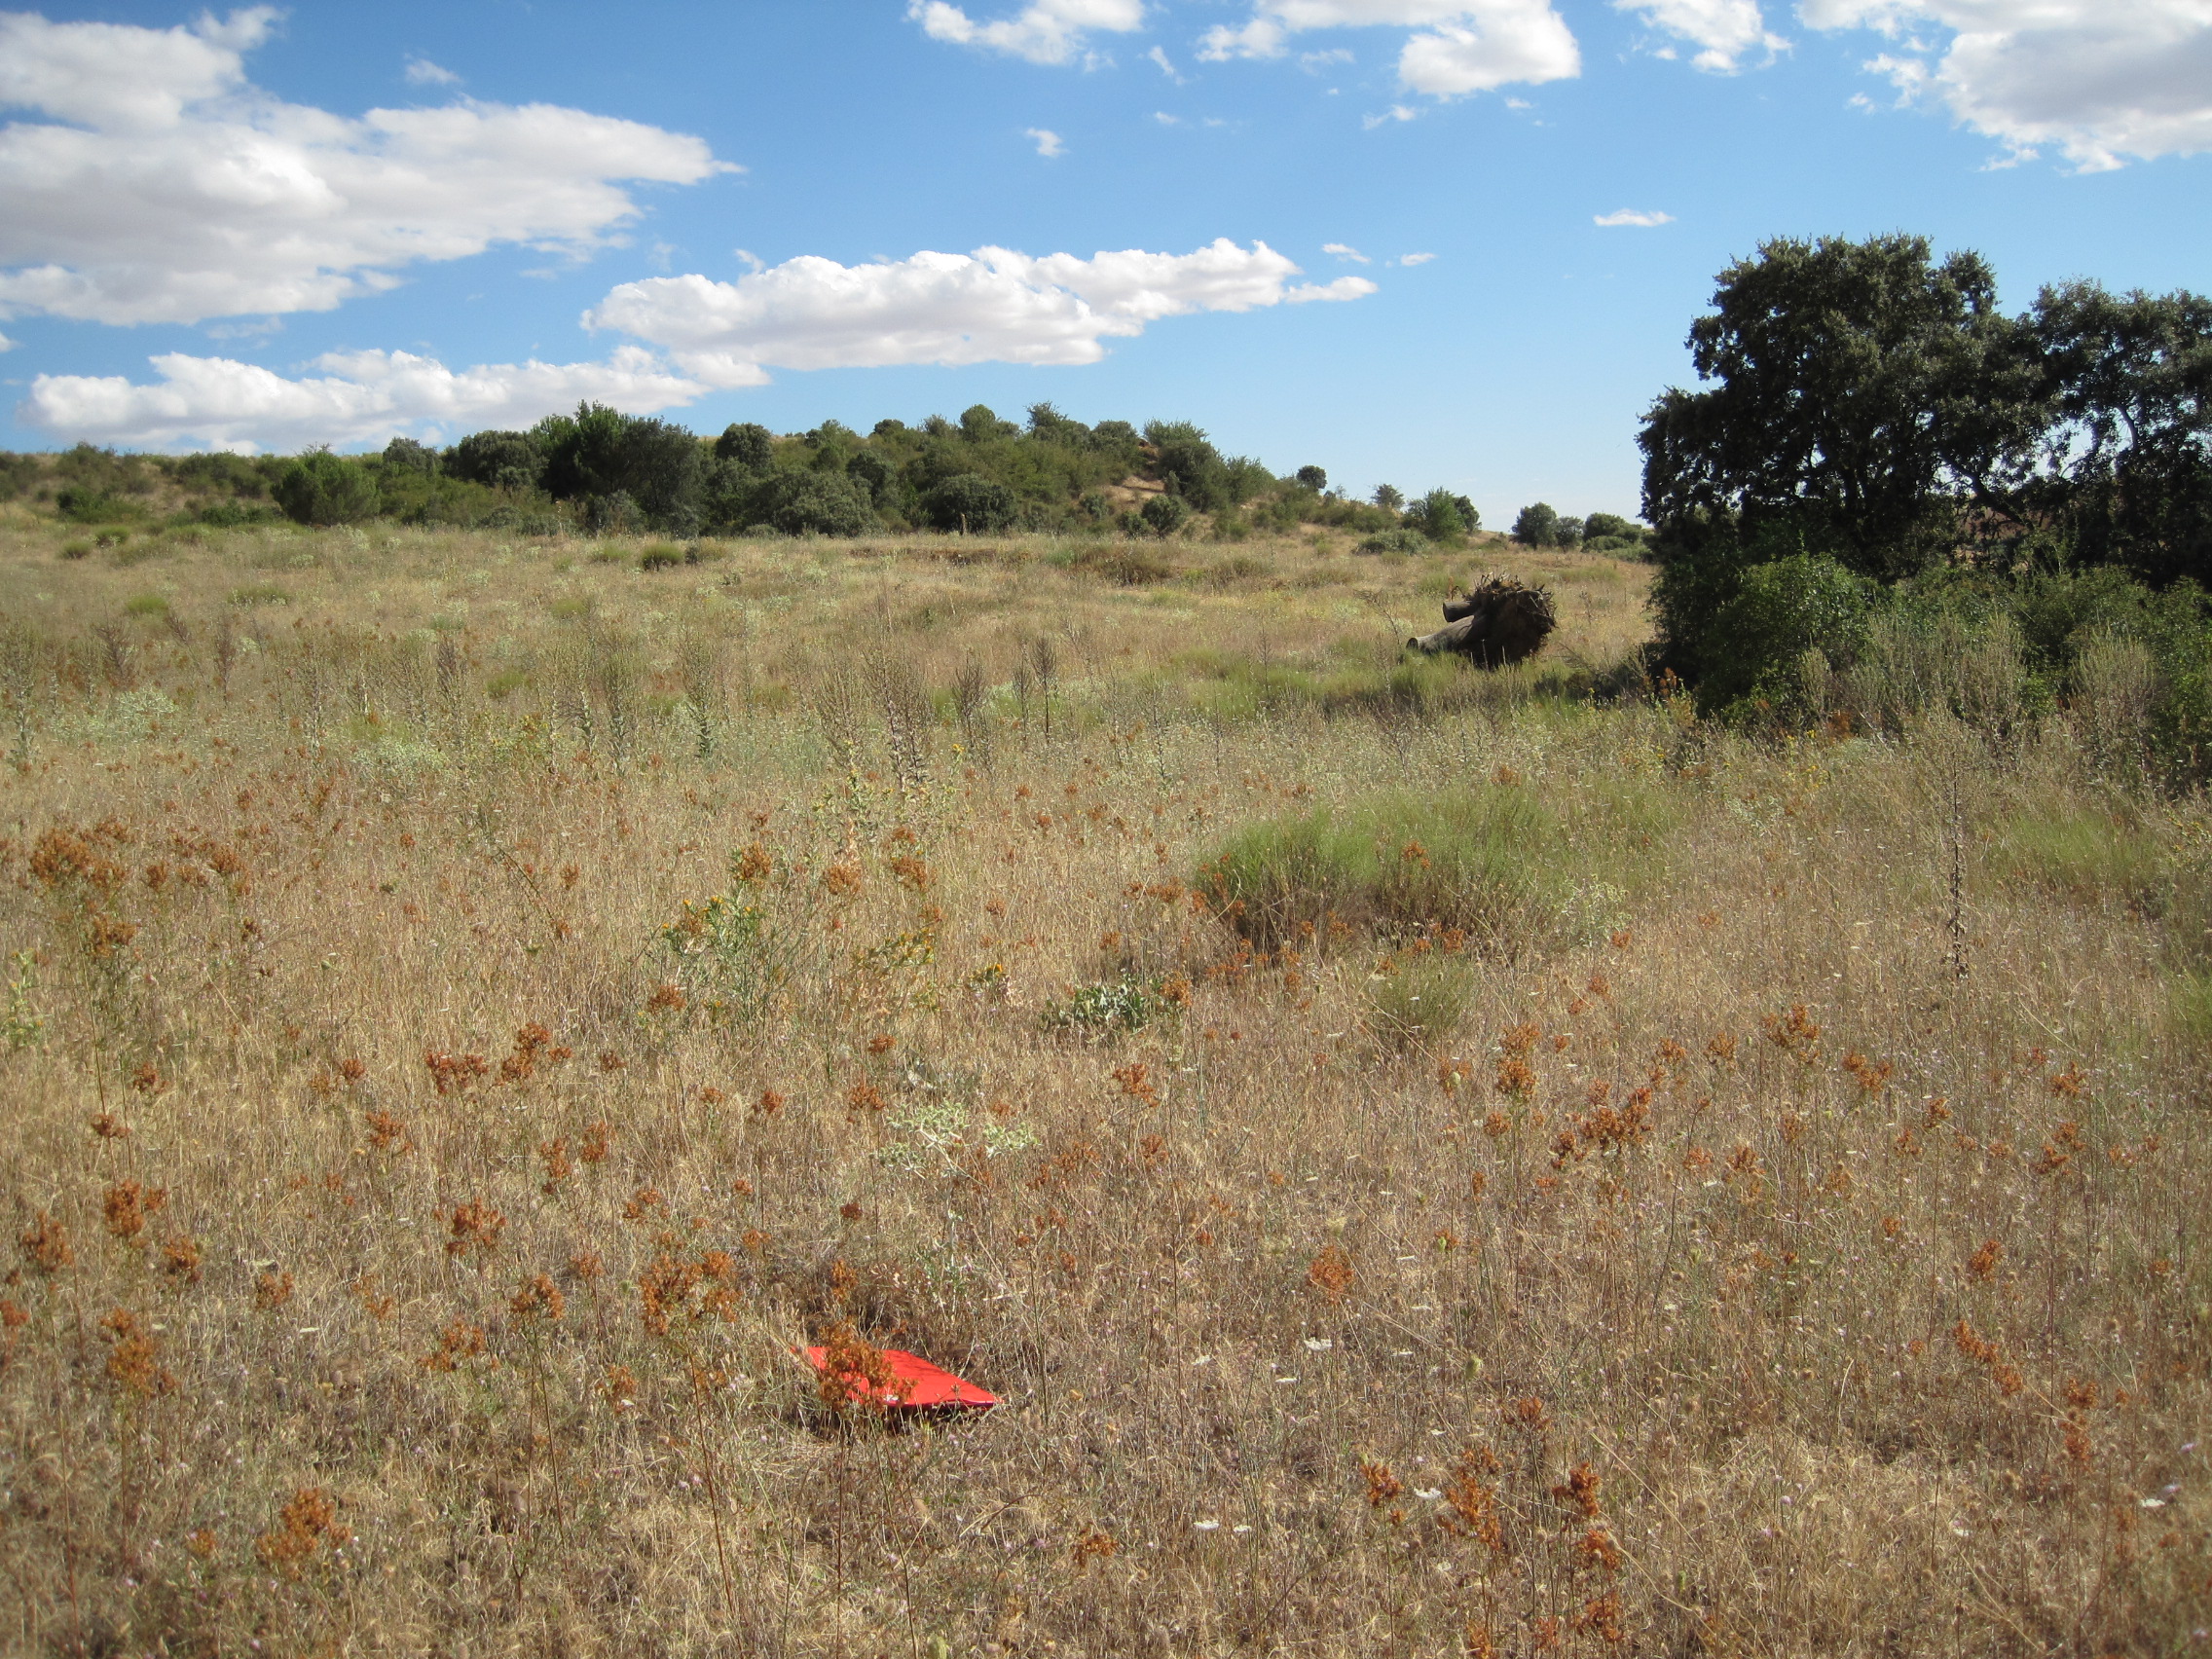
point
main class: Grassland
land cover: Grassland without tree/shrub cover
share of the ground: > 75 %
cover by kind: herbaceous plants 95 %, shrubs 5 %
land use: Semi-natural and natural areas not in use
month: July
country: ES
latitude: 42.0978
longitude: -5.4813
